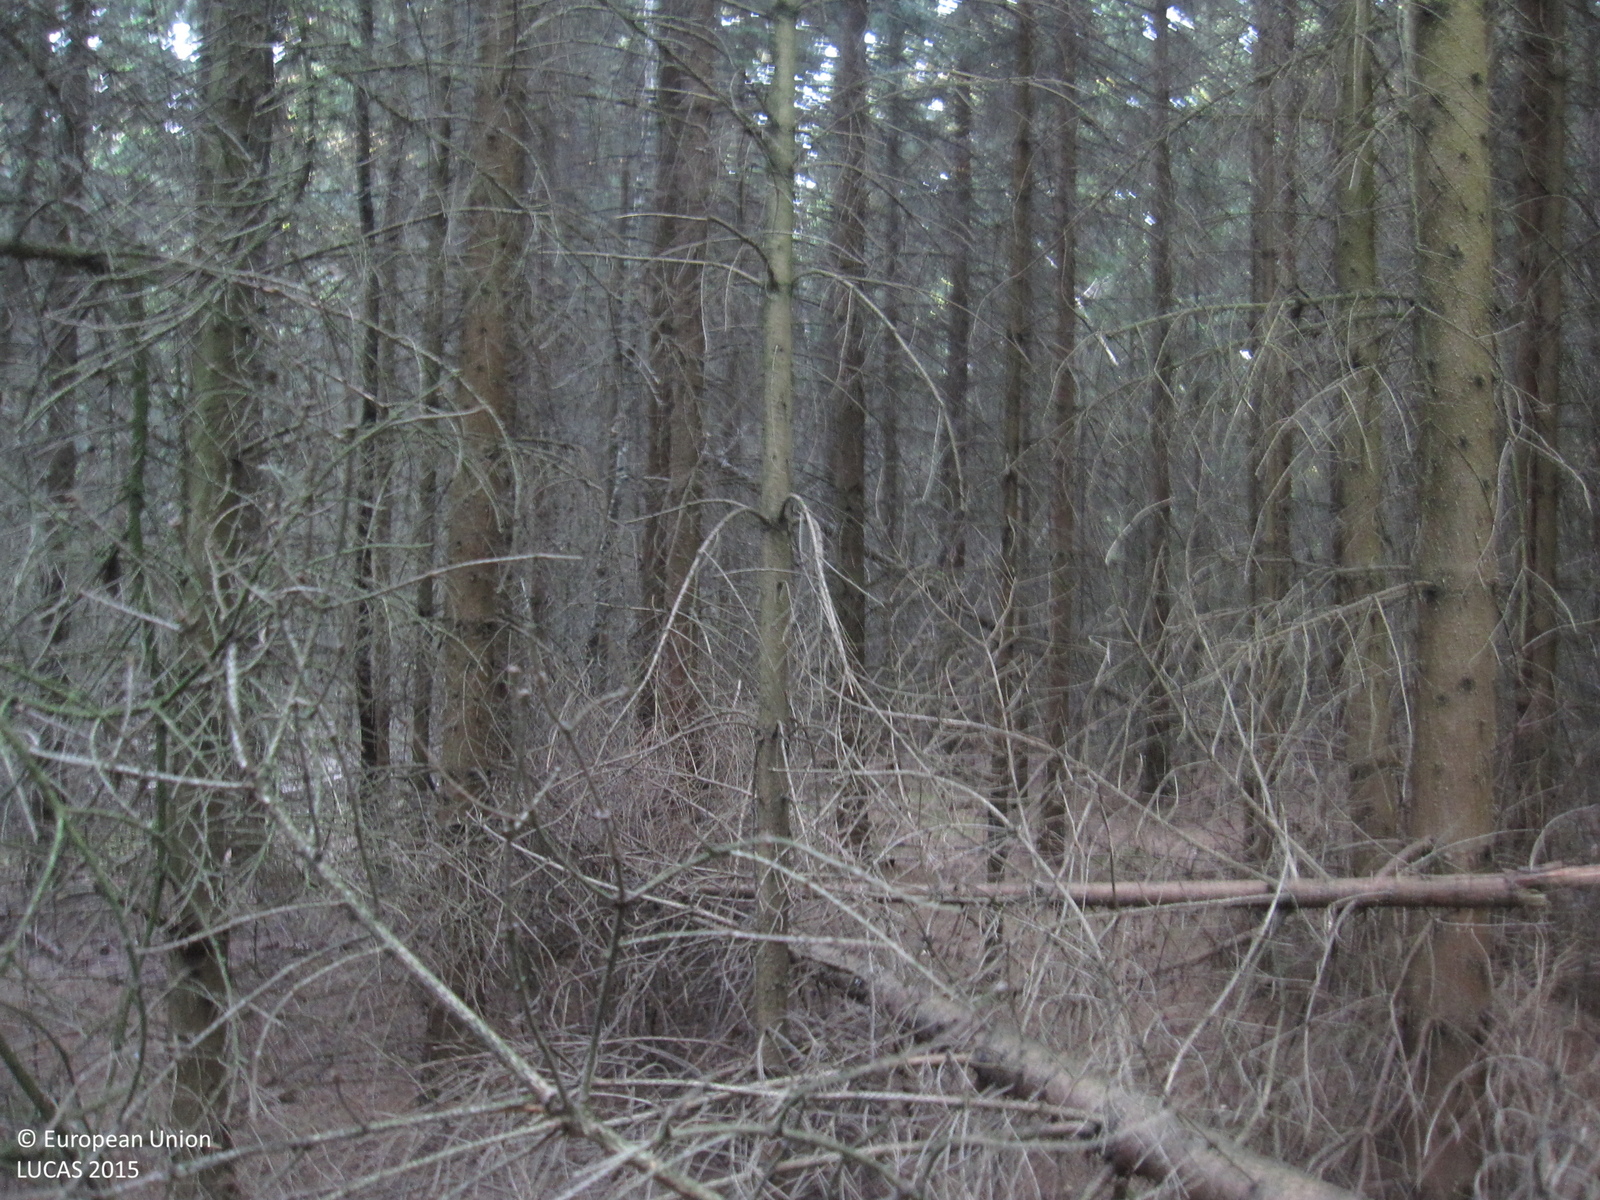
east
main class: Woodland
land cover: Spruce dominated coniferous woodland
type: hemiboreal forest and nemoral coniferous forest and mixed broadleaved-coniferous forest
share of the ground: > 75 %
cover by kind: coniferous forest trees 95 %, unconsolidated bare surface 5 %
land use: Forestry
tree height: > 5 m
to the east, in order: Spruce dominated coniferous woodland; Tracks; Spruce dominated coniferous woodland; Tracks; Spruce dominated coniferous woodland; Sunflower
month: August
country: DE
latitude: 50.5446
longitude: 11.9894
